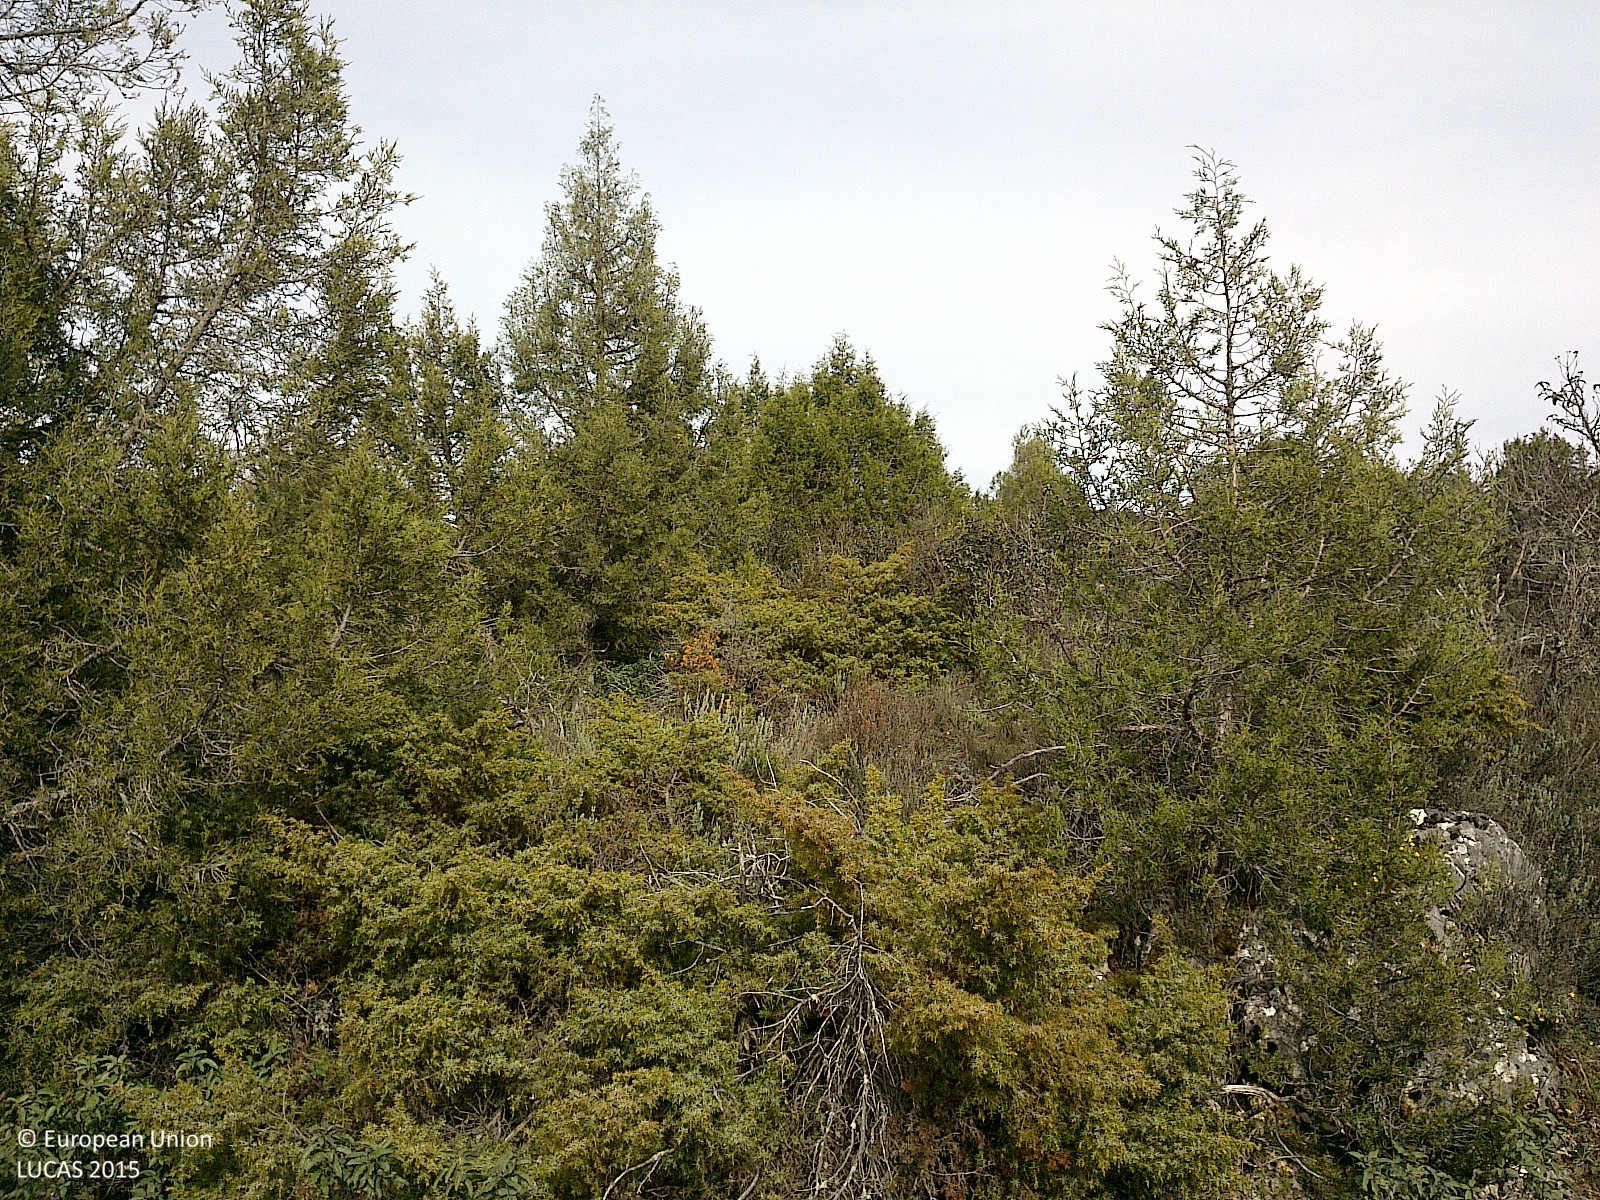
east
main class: Shrubland
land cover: Shrubland with sparse tree cover
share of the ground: 50 - 75 %
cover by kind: shrubs 65 %, herbaceous plants 20 %, unconsolidated bare surface 10 %, coniferous forest trees 5 %
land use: Semi-natural and natural areas not in use
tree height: > 5 m
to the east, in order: Shrubland with sparse tree cover; Other coniferous woodland; Shrubland with sparse tree cover; Rye; Shrubland with sparse tree cover
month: April
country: ES
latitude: 41.7276
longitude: -3.0886
